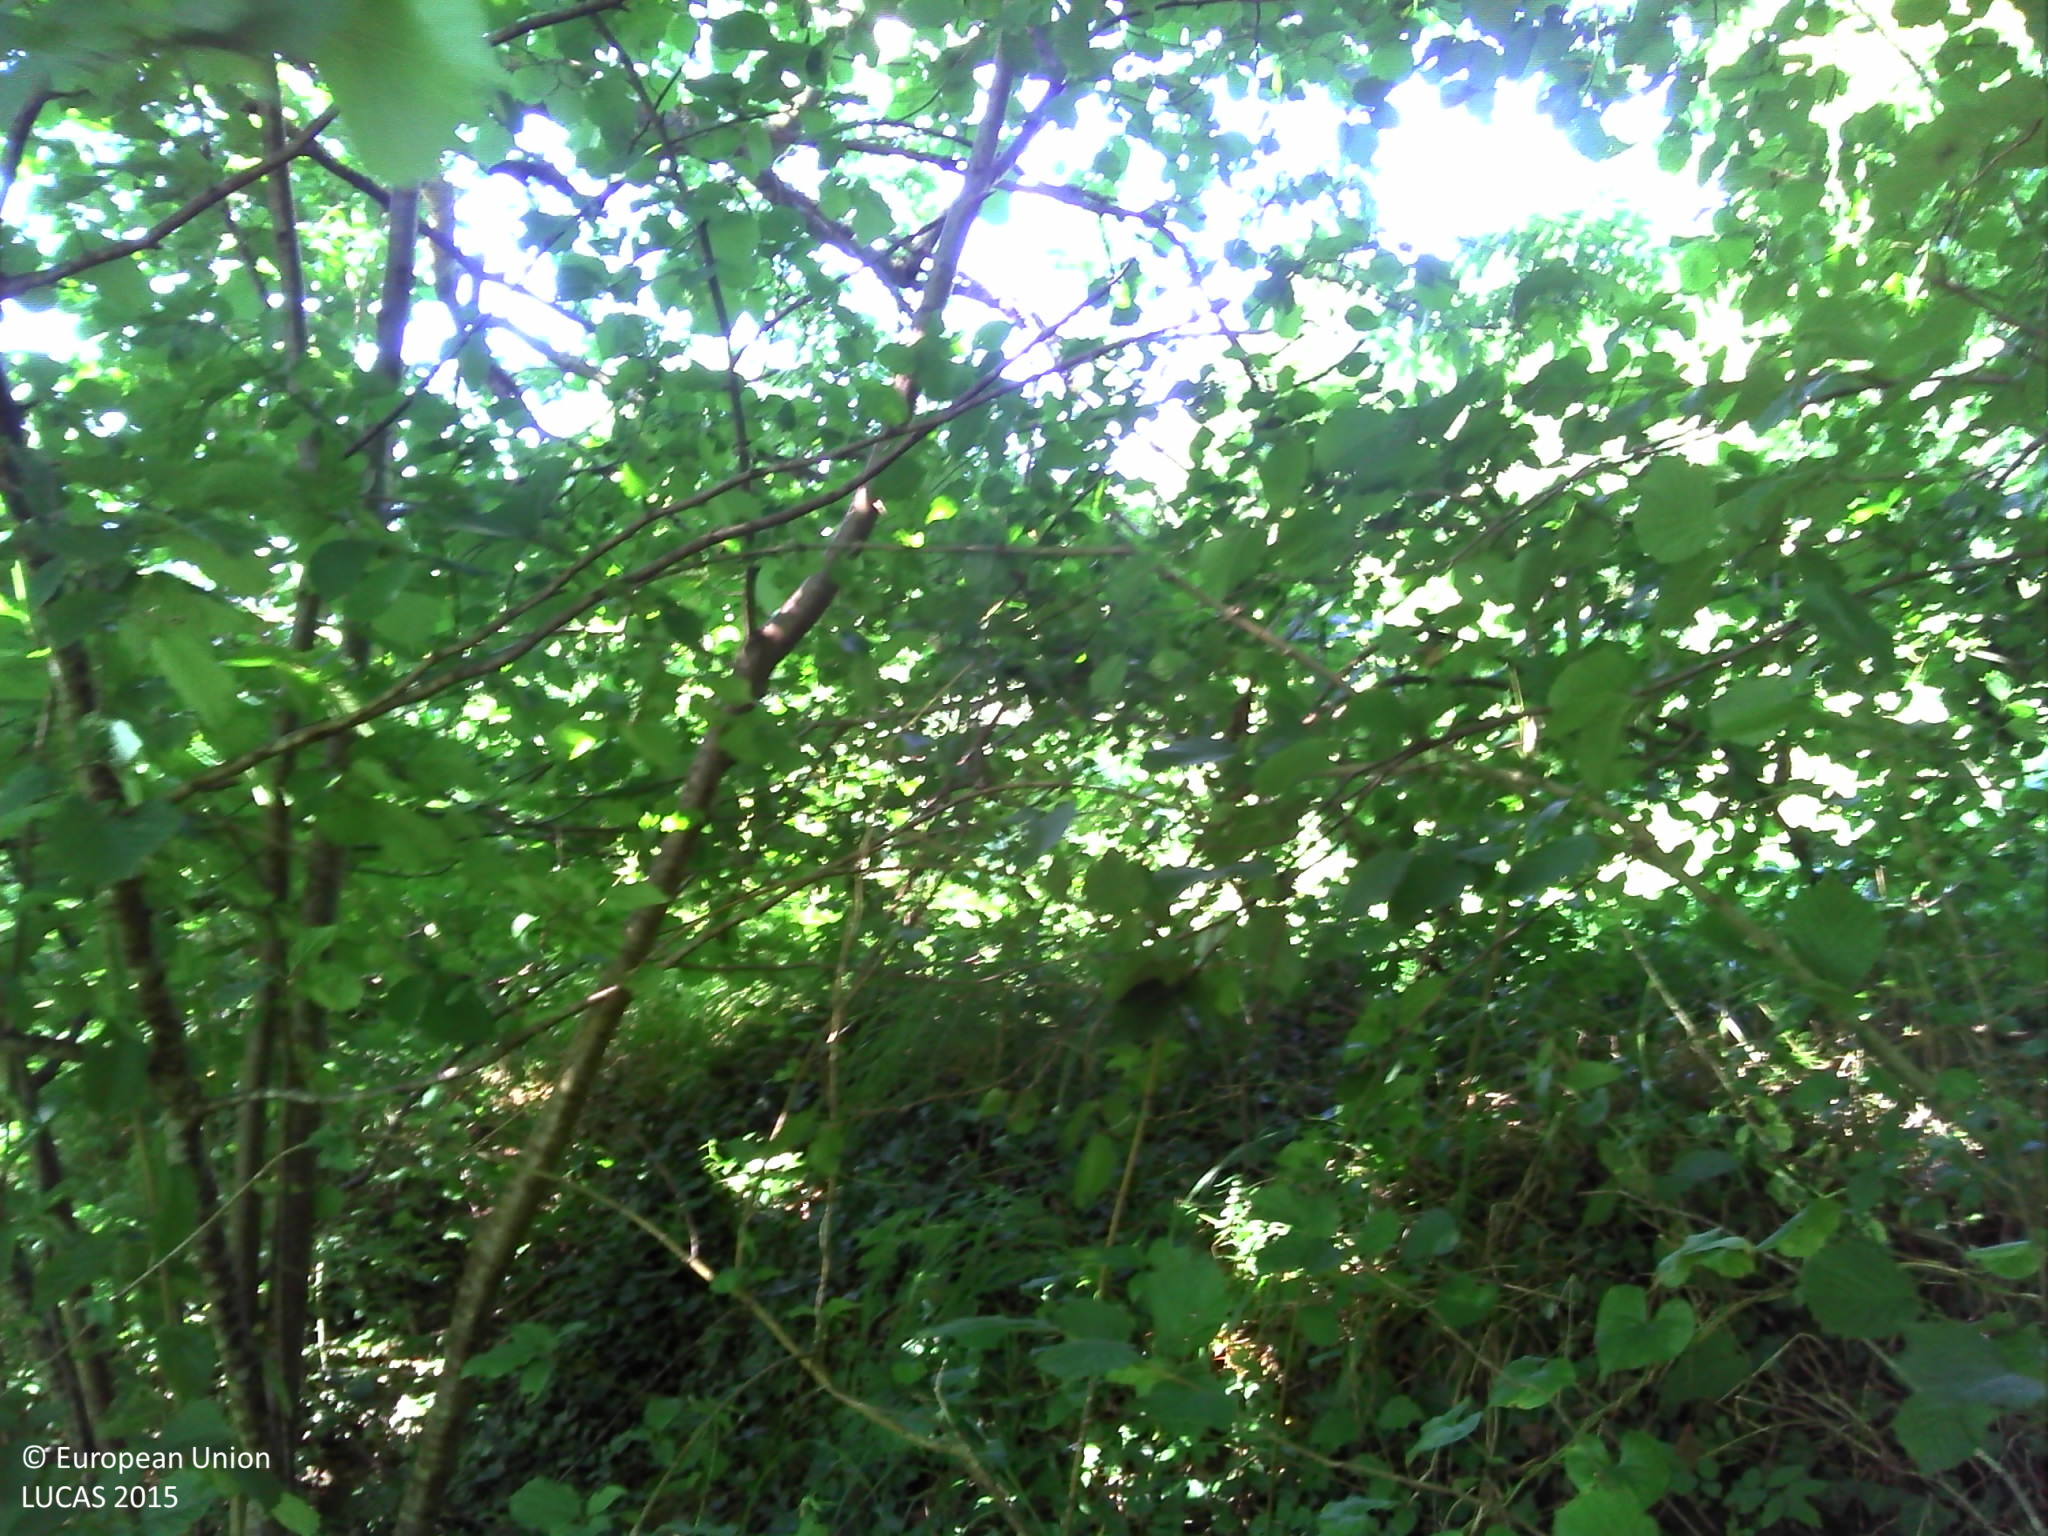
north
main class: Woodland
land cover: Broadleaved woodland
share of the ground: > 75 %
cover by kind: broadleaved forest trees 55 %, herbaceous plants 35 %, shrubs 10 %
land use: Agriculture (excluding fallow land and kitchen gardens)
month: July
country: FR
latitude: 42.9885
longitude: -0.4174
